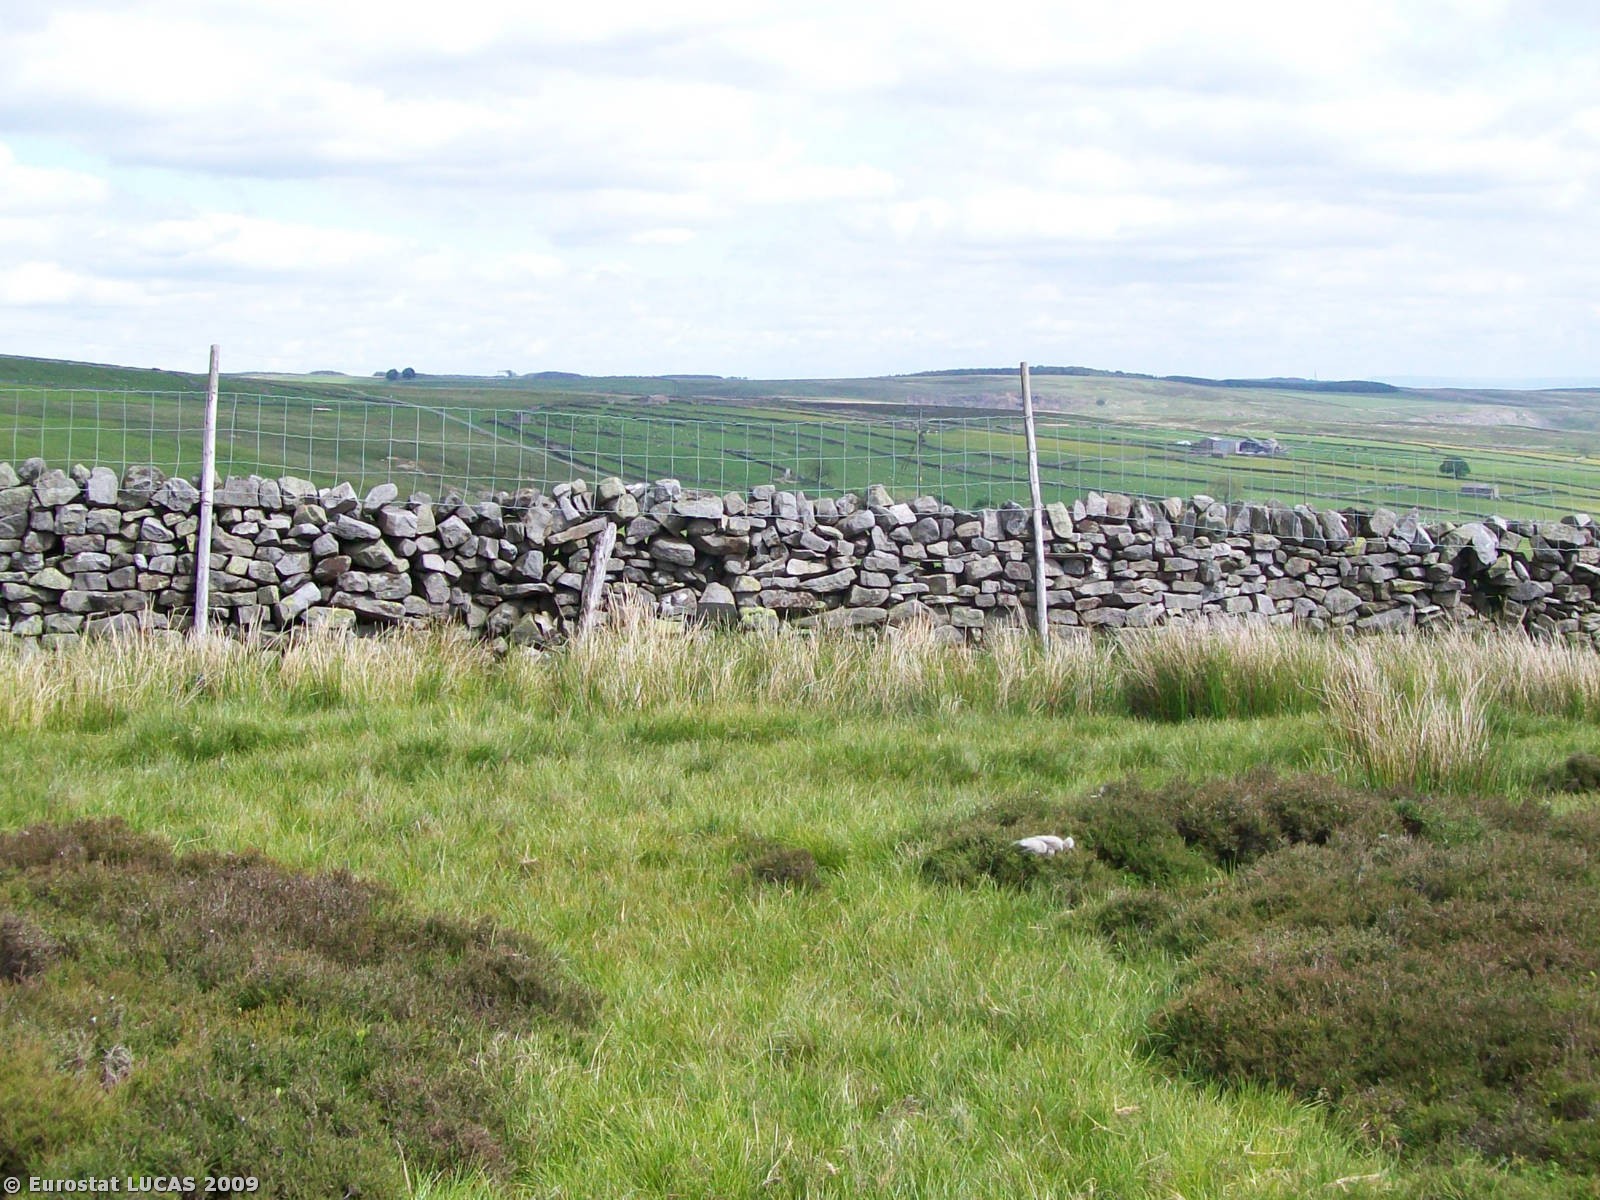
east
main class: Shrubland
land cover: Shrubland without tree cover
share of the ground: 50 - 75 %
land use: Agriculture (excluding fallow land and kitchen gardens)
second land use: Nature reserves
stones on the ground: < 10 %
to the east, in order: Shrubland without tree cover; Dry stone walls; Grassland without tree/shrub cover
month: June
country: GB
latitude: 54.4302
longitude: -1.9088
